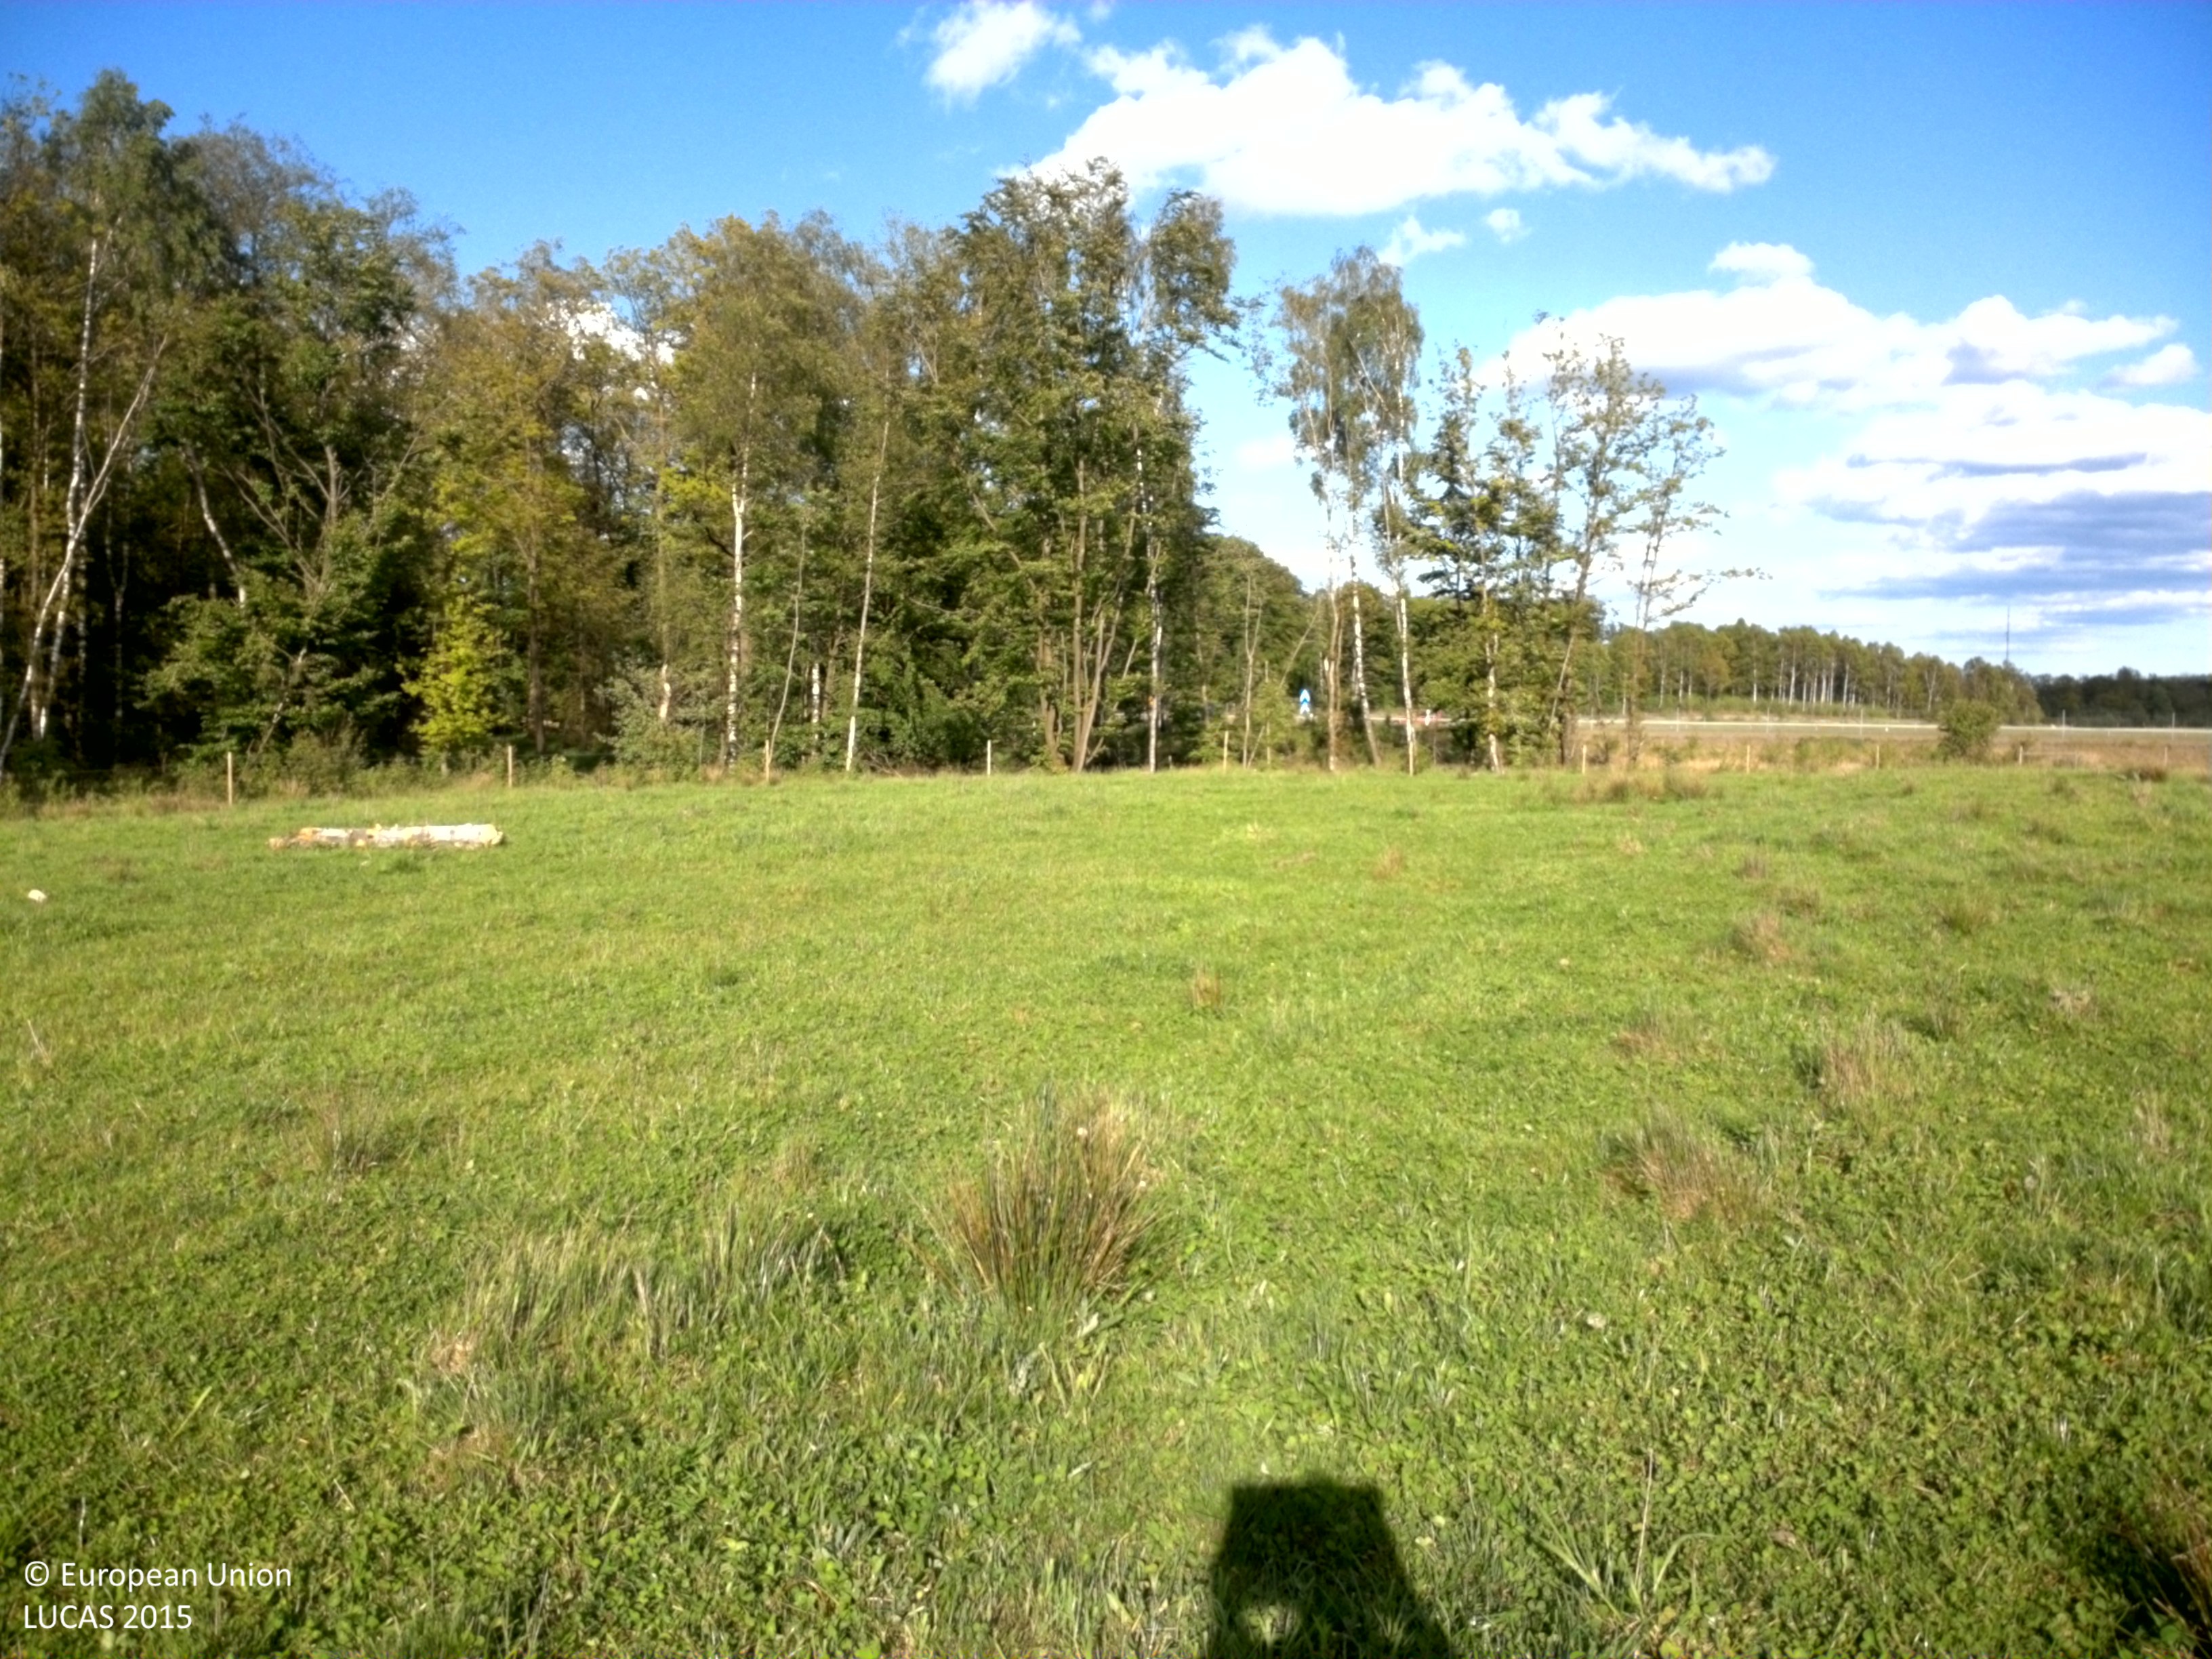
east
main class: Grassland
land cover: Grassland without tree/shrub cover
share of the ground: > 75 %
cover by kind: herbaceous plants 100 %
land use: Agriculture (excluding fallow land and kitchen gardens)
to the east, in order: Grassland without tree/shrub cover; Fences; Spontaneously vegetated surfaces; Ditches and canals; Broadleaved woodland; Grass margins; Ditches and canals; Grass margins; Paved roads, cycling and walking lanes; Grass margins; Fences; Grass margins; Paved roads, cycling and walking lanes; Grass margins; Paved roads, cycling and walking lanes; Fences; Grass margins; Paved roads, cycling and walking lanes; Spontaneously vegetated surfaces; Broadleaved woodland
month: June
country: SE
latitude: 55.8998
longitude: 13.7243
